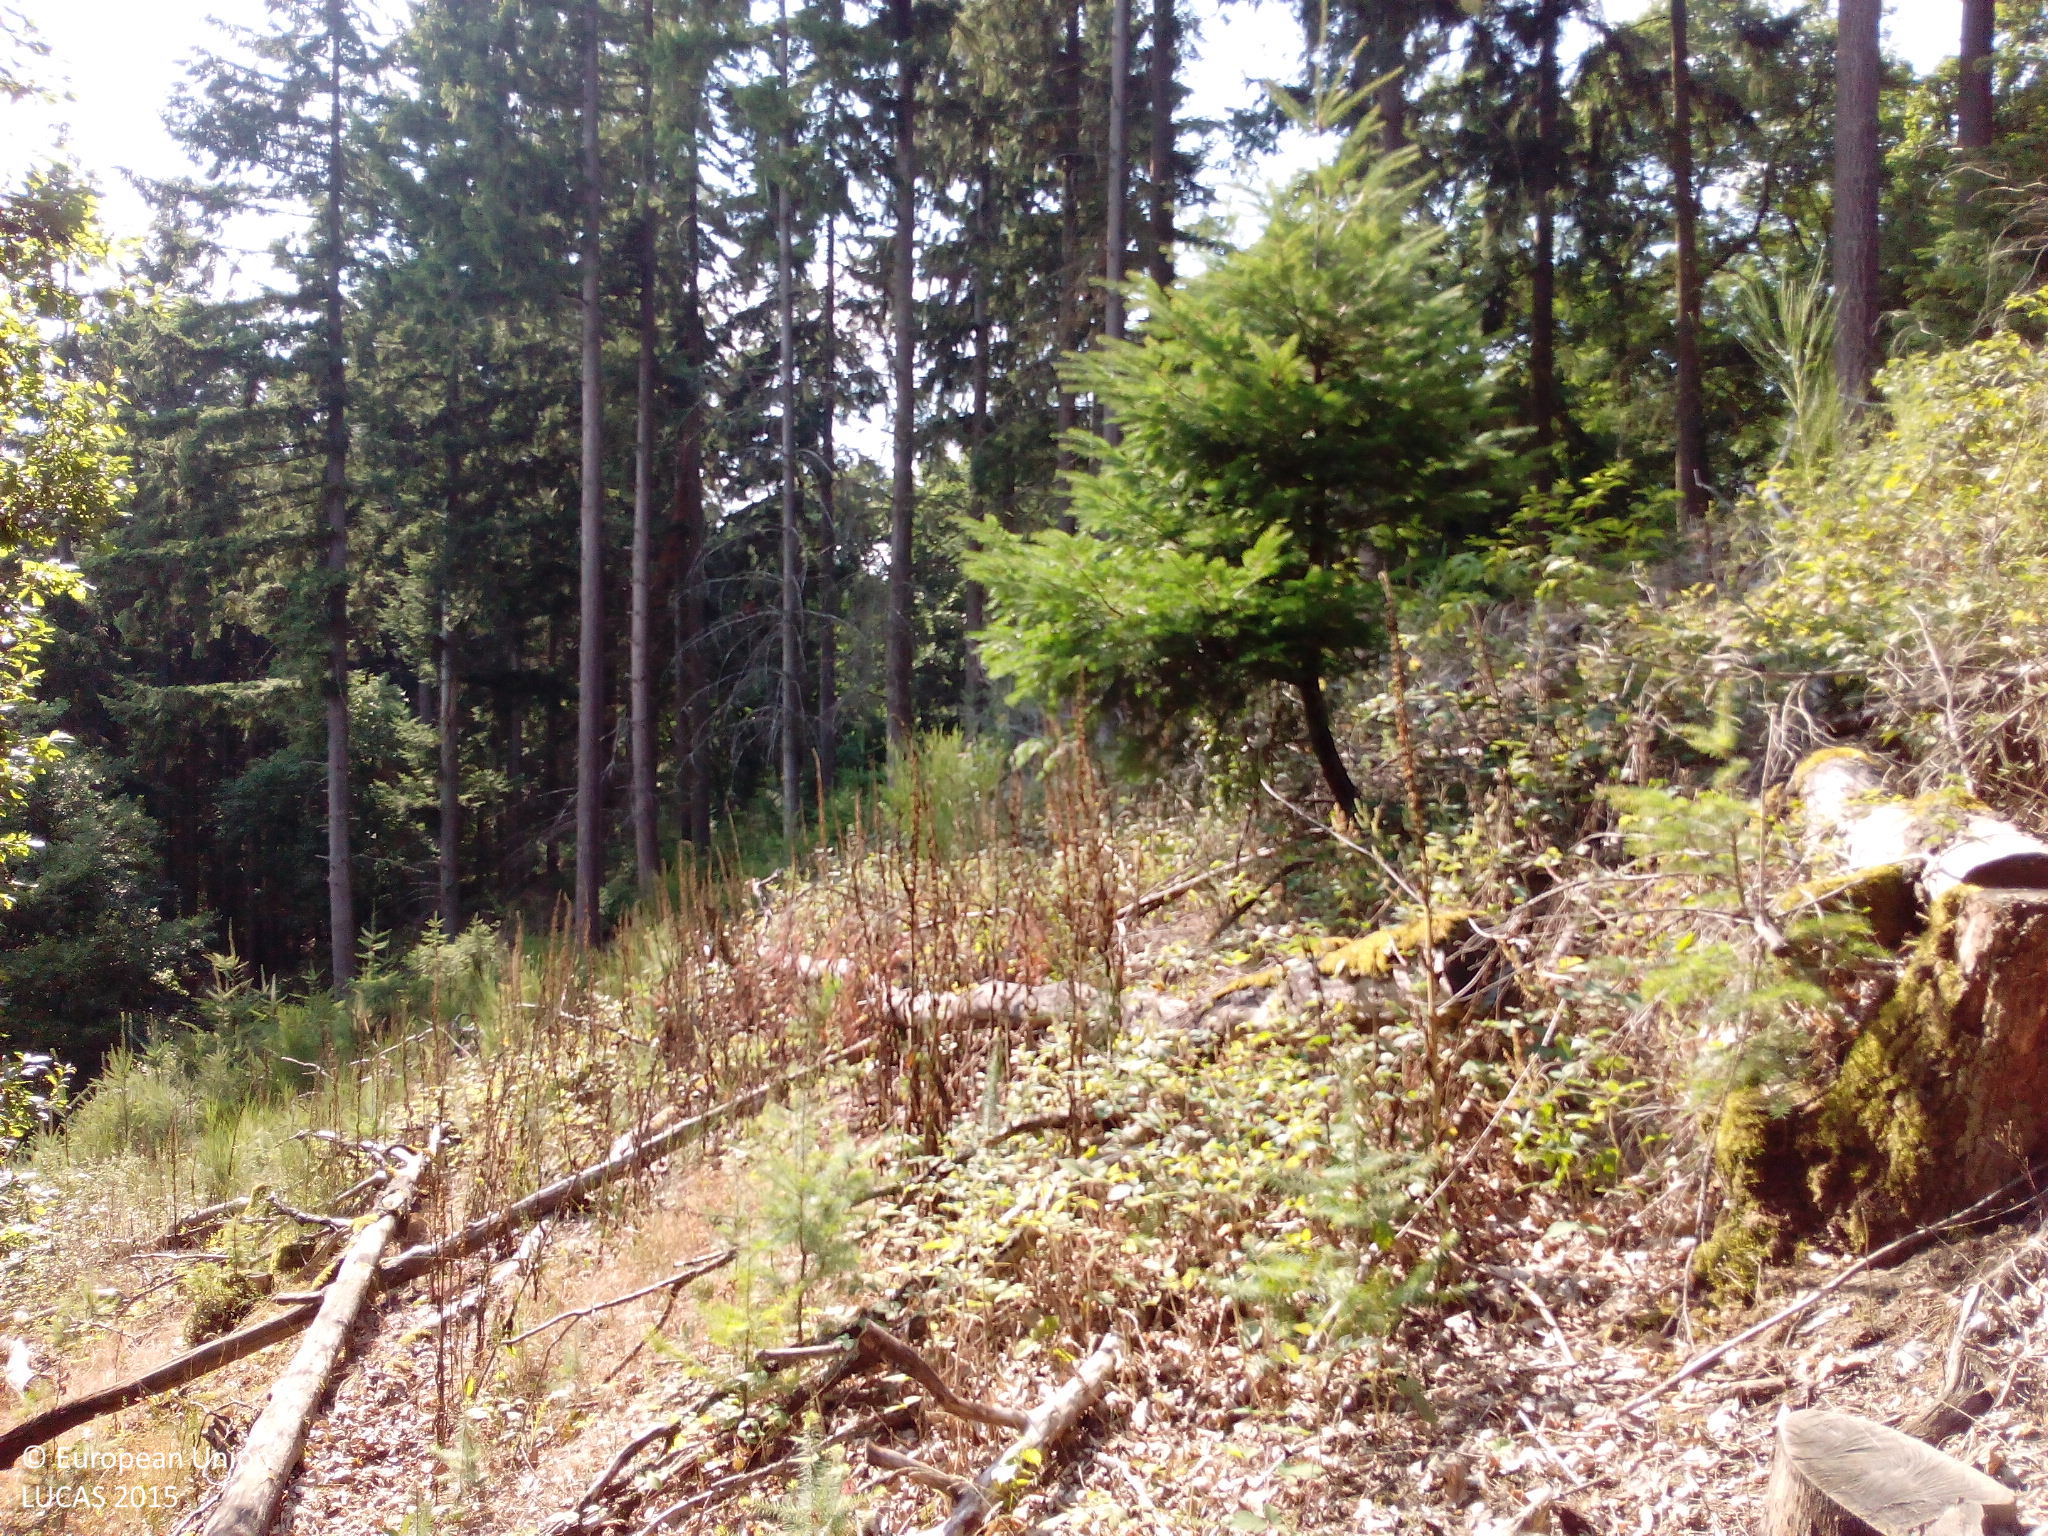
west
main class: Woodland
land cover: Broadleaved woodland
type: mesophytic deciduous forest
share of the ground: > 75 %
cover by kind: broadleaved forest trees 90 %, herbaceous plants 10 %
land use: Forestry
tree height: > 5 m
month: August
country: DE
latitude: 50.1388
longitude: 7.4958
